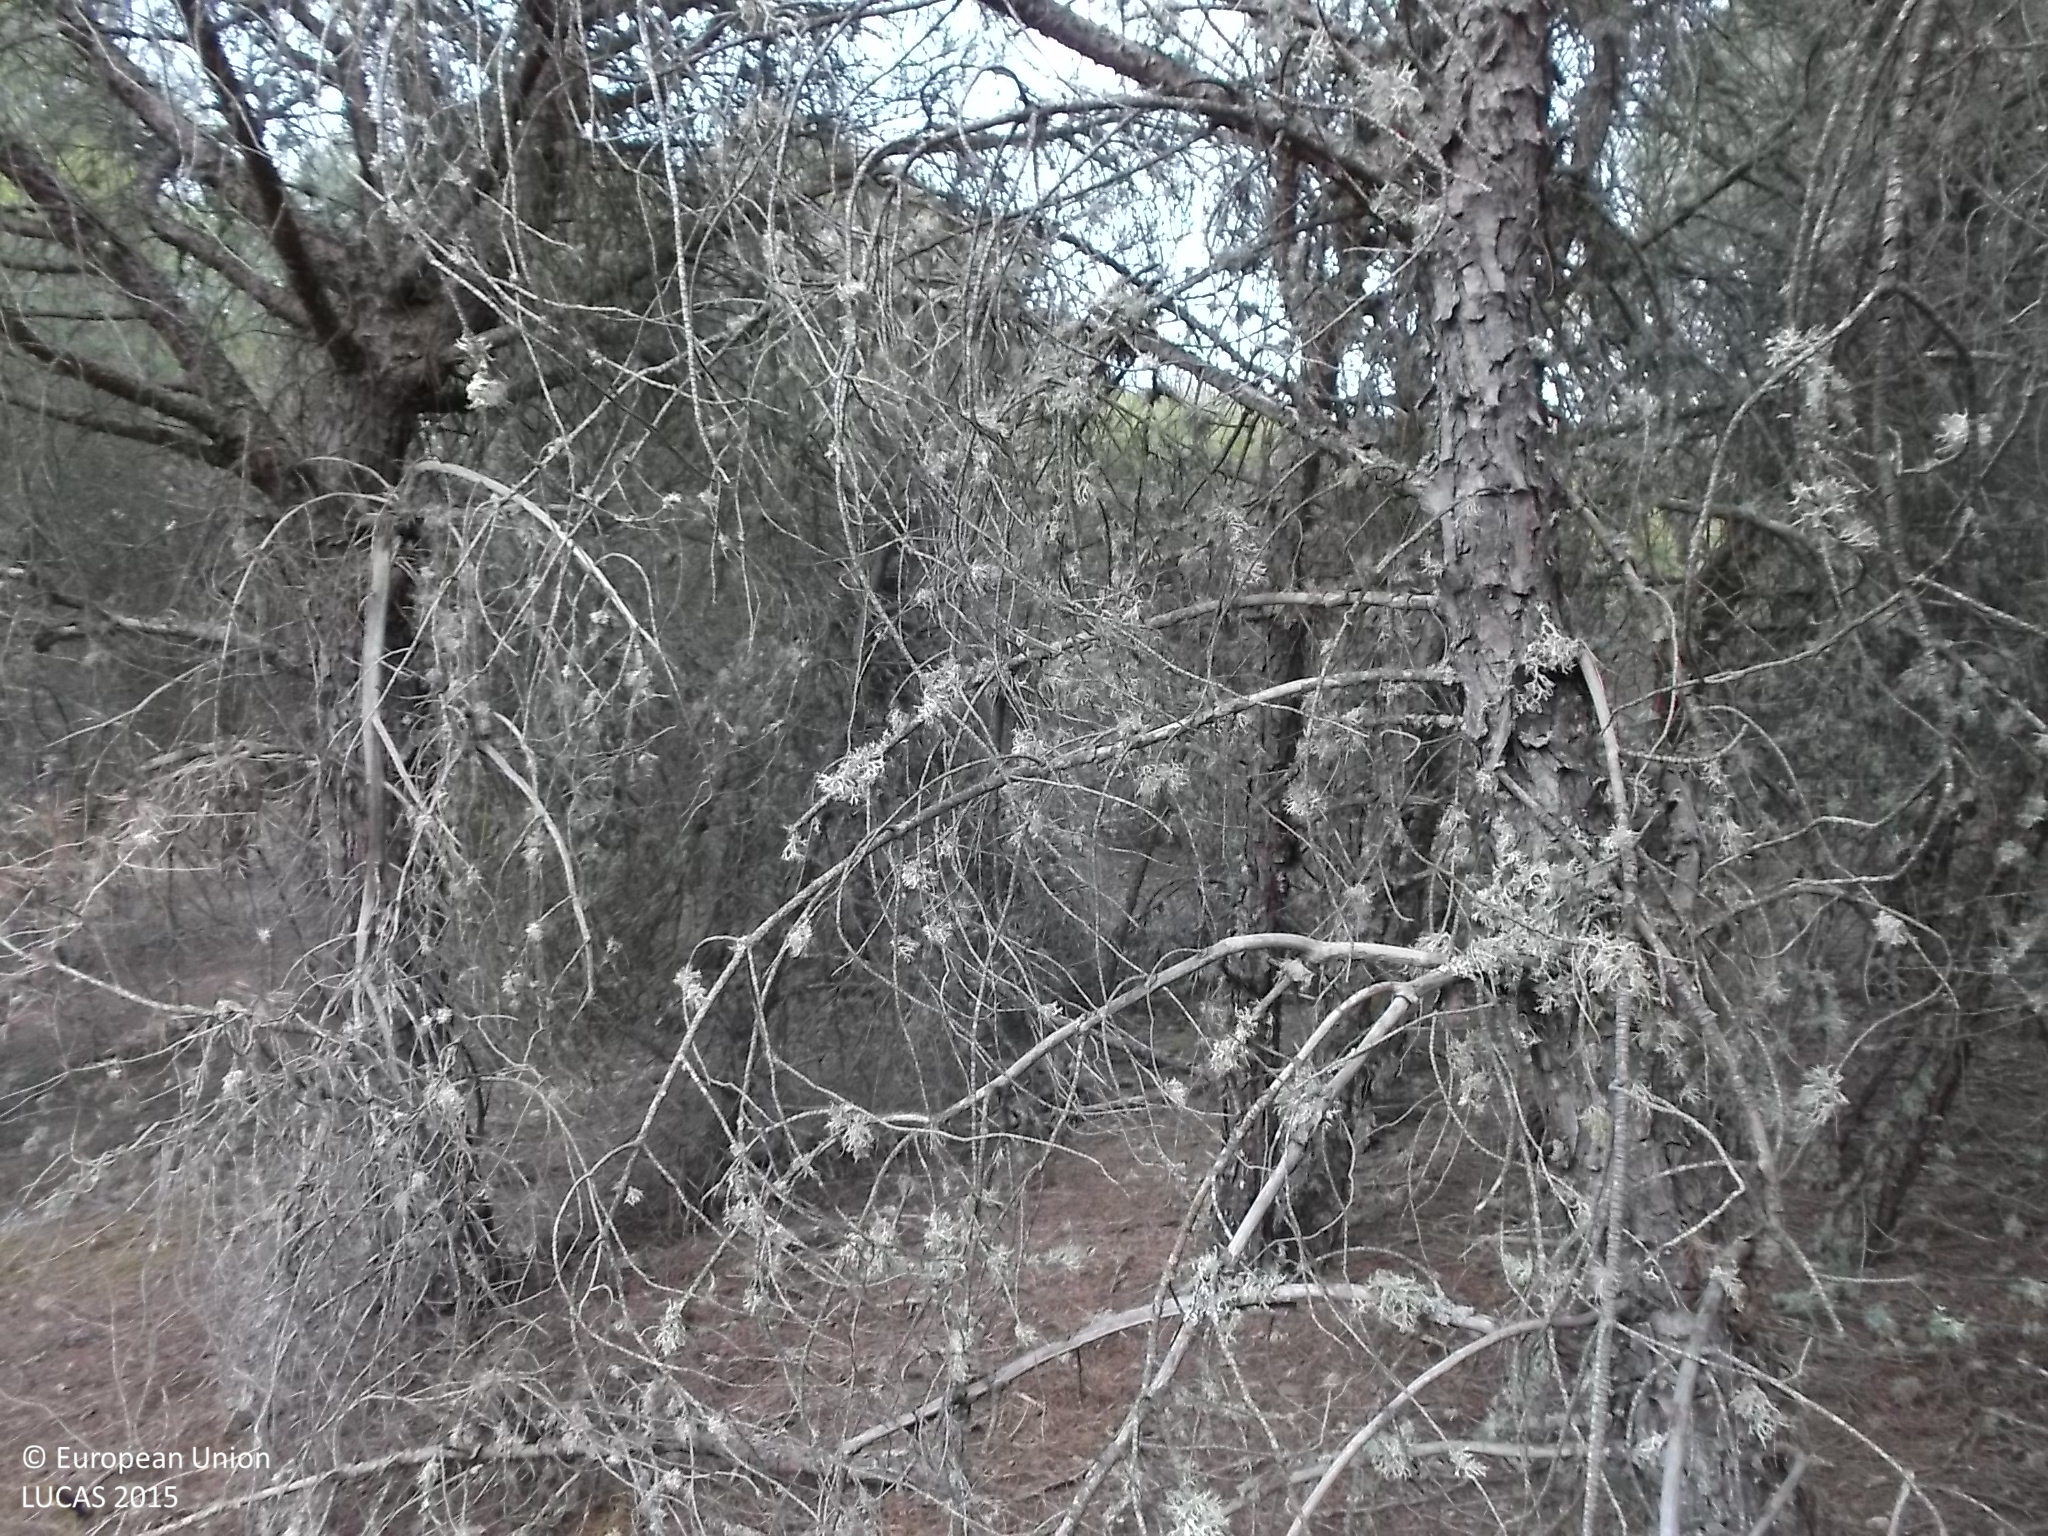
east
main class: Woodland
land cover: Pine dominated coniferous woodland
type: coniferous forest of the mediterranean region
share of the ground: > 75 %
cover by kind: coniferous forest trees 80 %, shrubs 20 %
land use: Semi-natural and natural areas not in use
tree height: > 5 m
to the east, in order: Pine dominated coniferous woodland; Pine dominated mixed woodland; Spontaneously vegetated surfaces; Pine dominated mixed woodland
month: July
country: ES
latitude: 41.5361
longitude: -5.4349
